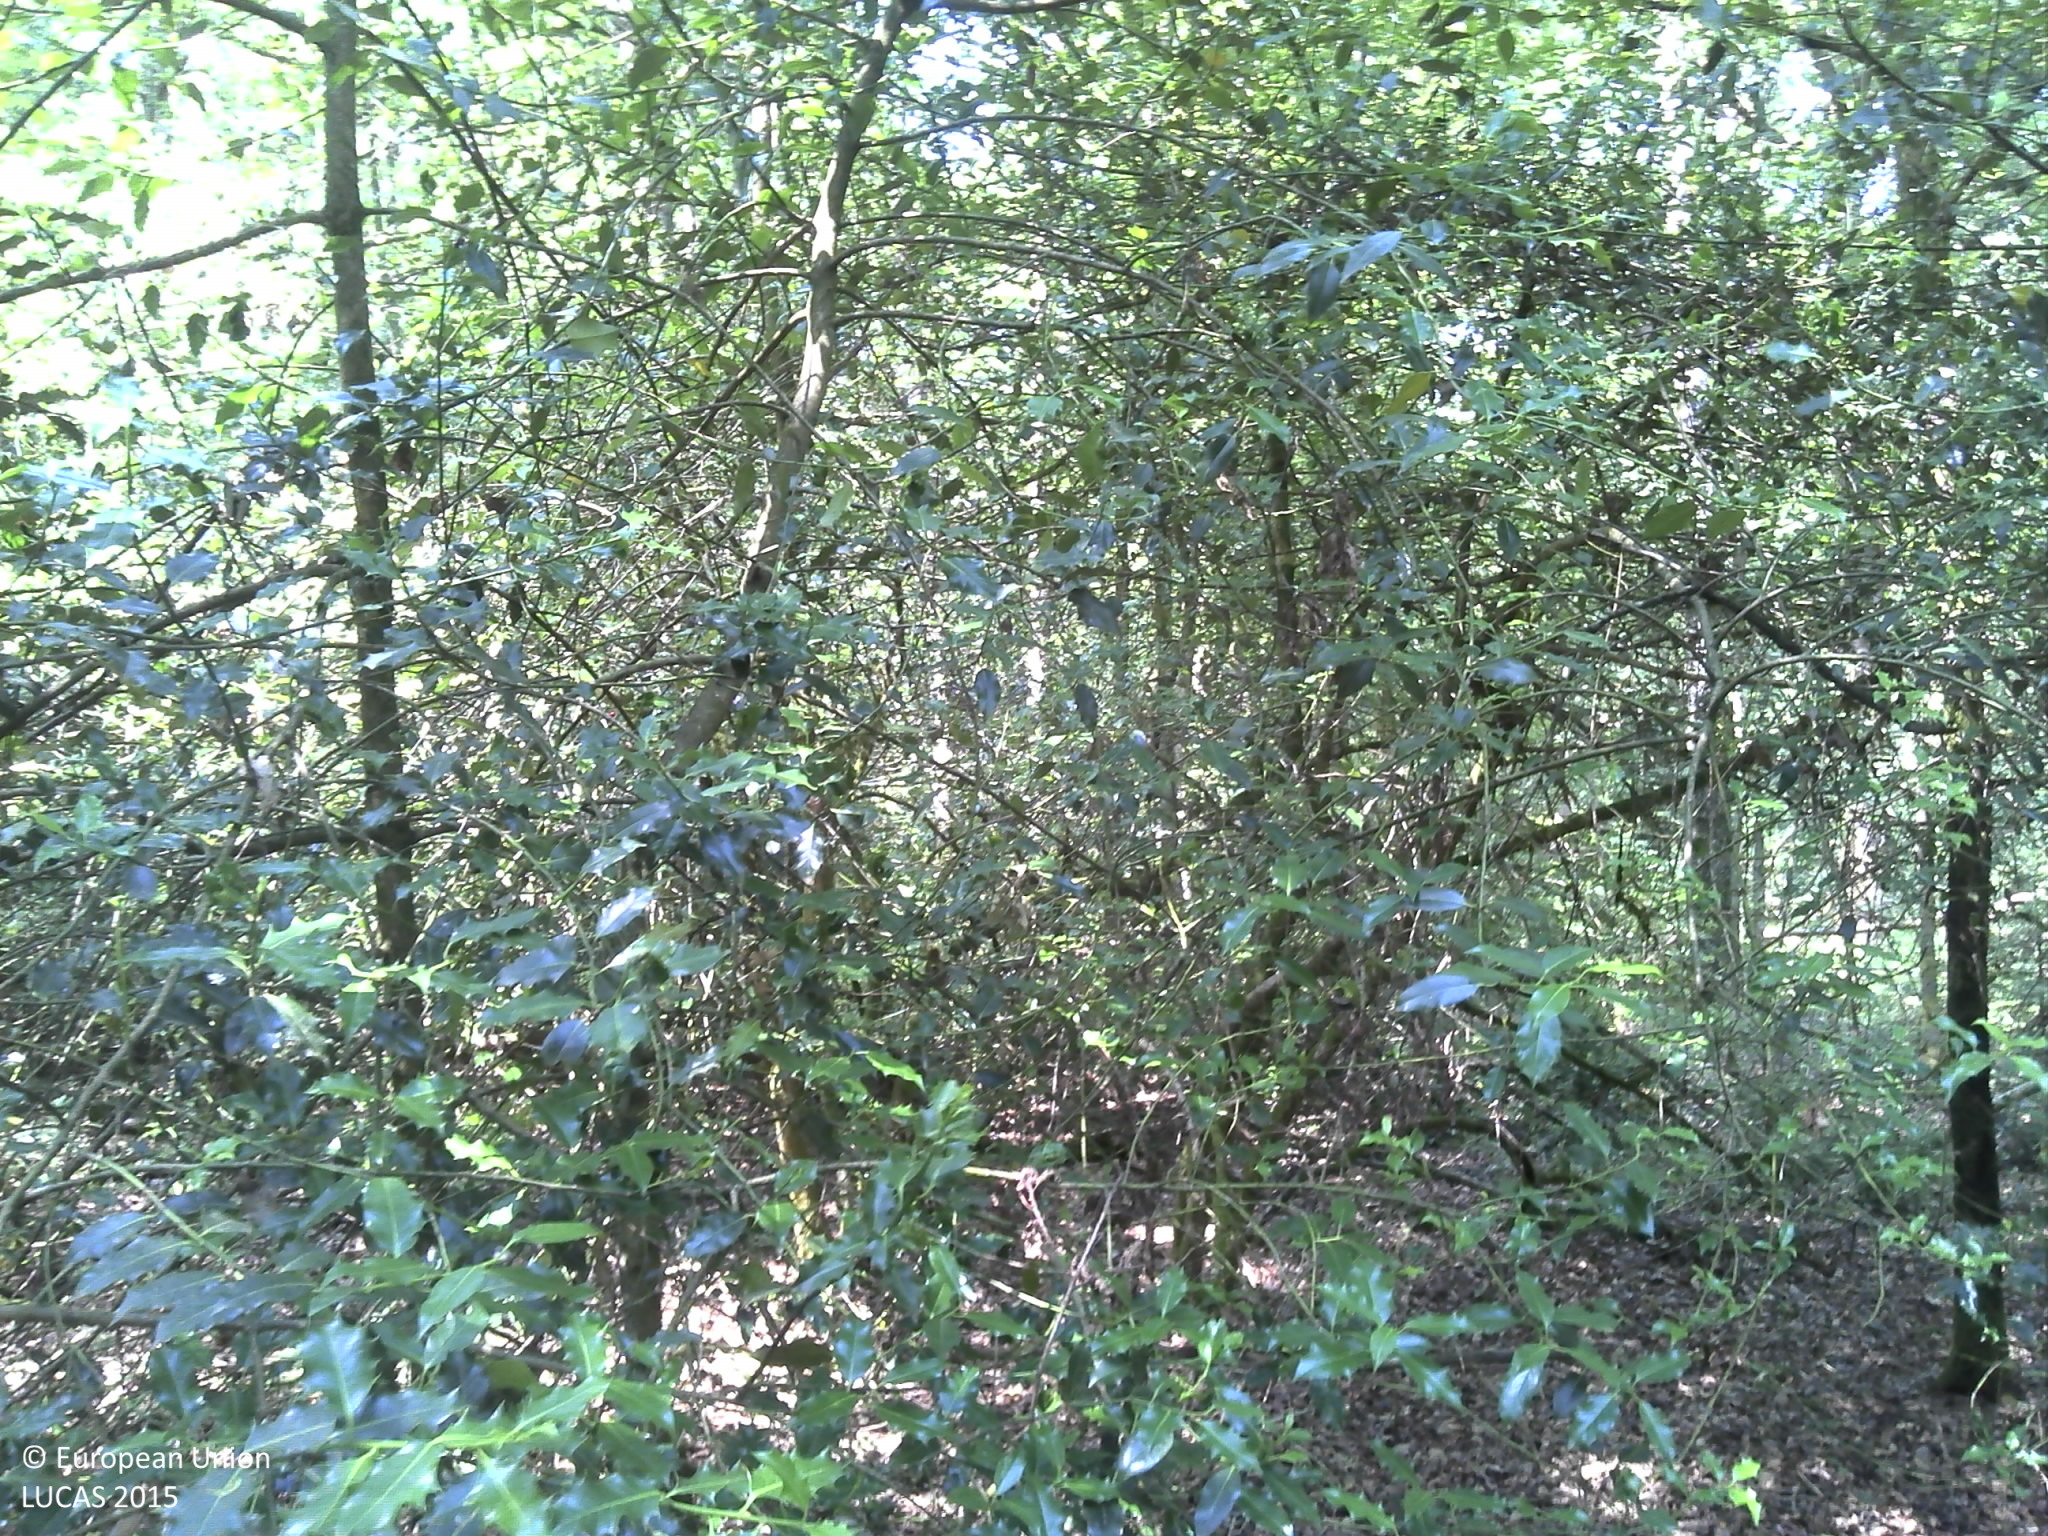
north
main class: Woodland
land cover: Broadleaved woodland
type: acidophilous oak and oak-birch forest
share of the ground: 50 - 75 %
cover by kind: broadleaved forest trees 60 %, herbaceous plants 20 %, coniferous forest trees 10 %, consolidated bare surface 10 %
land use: Forestry
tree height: > 5 m
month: July
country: FR
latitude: 49.9036
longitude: 4.8035
